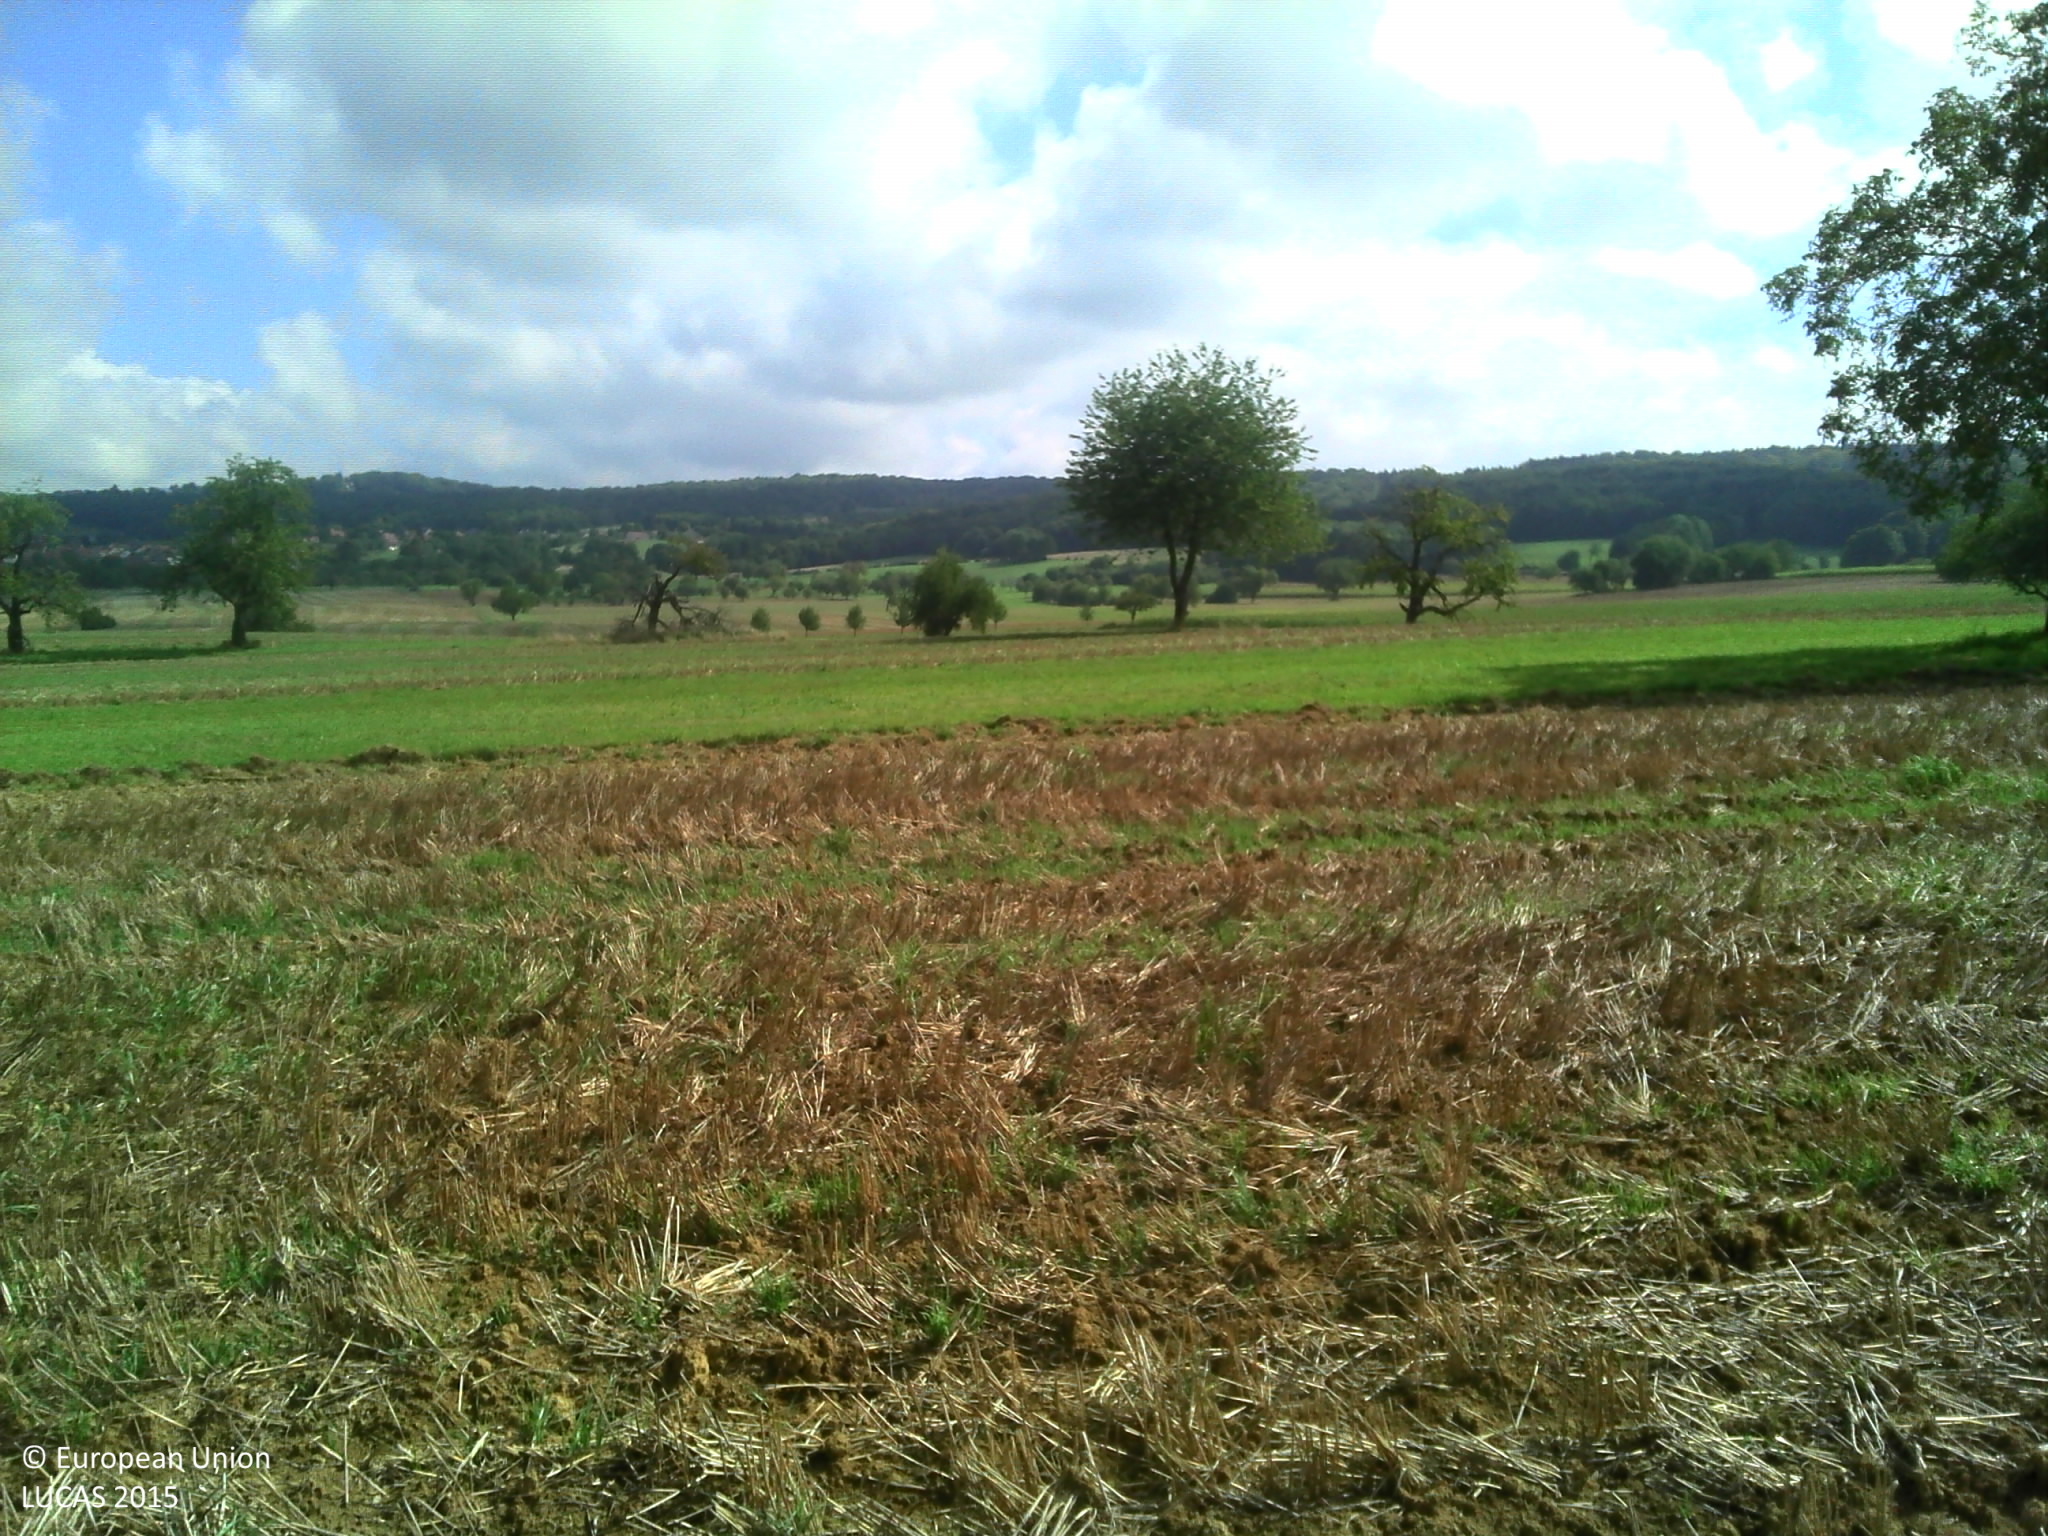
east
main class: Cropland
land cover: Common wheat
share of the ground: 50 - 75 %
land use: Agriculture (excluding fallow land and kitchen gardens)
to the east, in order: Common wheat; Grassland without tree/shrub cover; Common wheat; Single bushes/trees; Common wheat; Grassland without tree/shrub cover; Common wheat
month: September
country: FR
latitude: 47.4591
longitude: 6.8845
